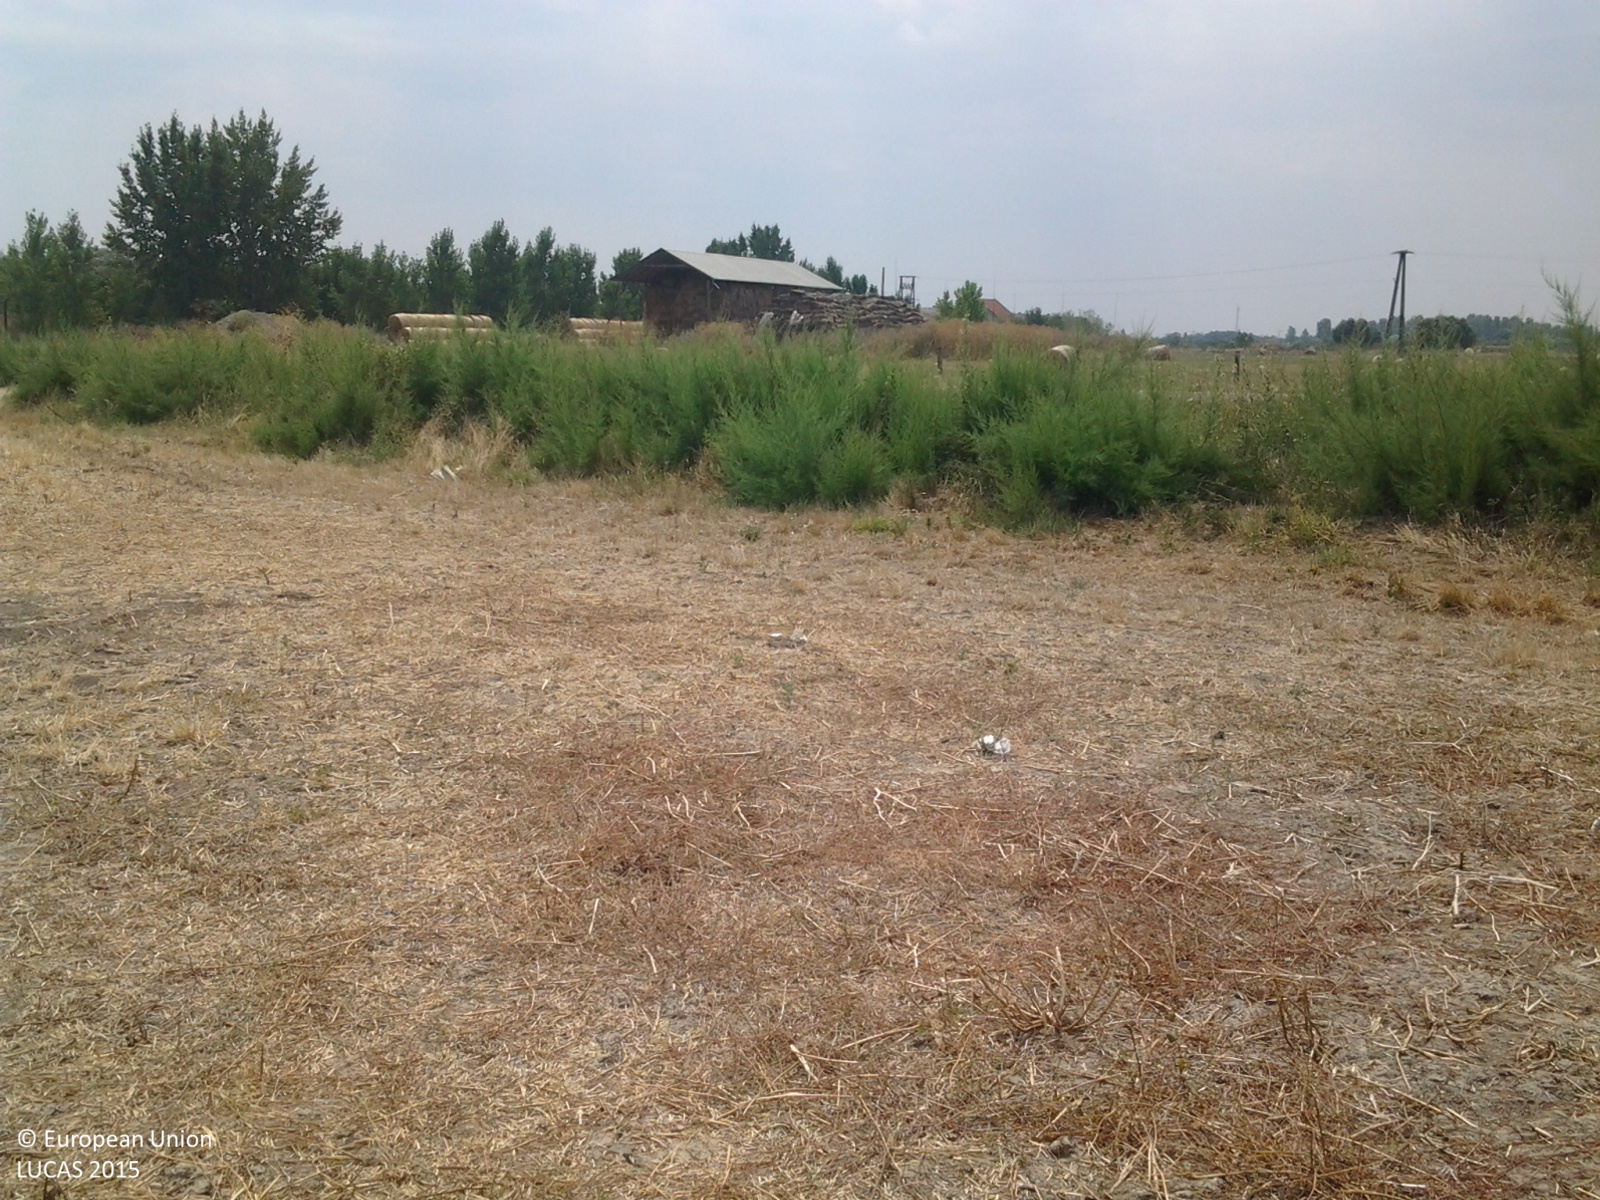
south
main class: Cropland
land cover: Rape and turnip rape
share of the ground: < 10 %
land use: Agriculture (excluding fallow land and kitchen gardens)
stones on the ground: < 10 %
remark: Harvested field
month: July
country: HU
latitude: 46.7683
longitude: 21.4705
